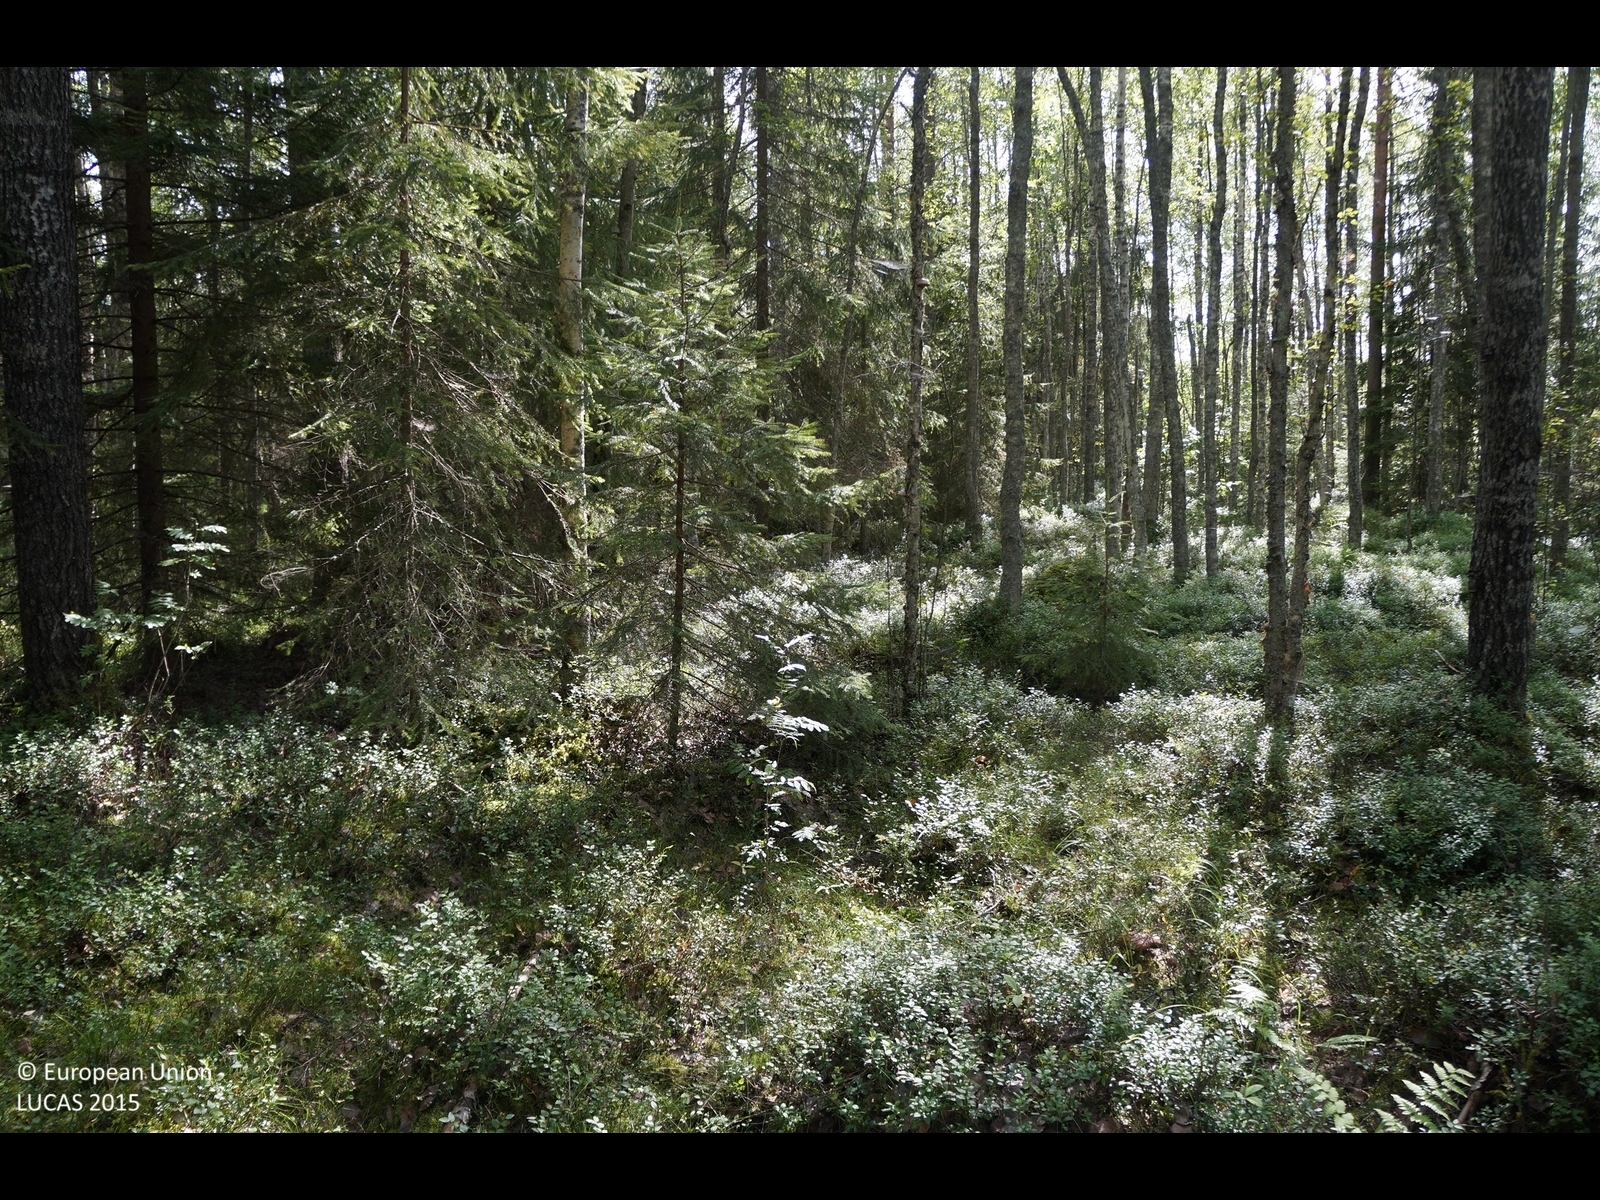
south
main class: Woodland
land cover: Spruce dominated mixed woodland
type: boreal forest
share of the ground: 50 - 75 %
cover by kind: coniferous forest trees 40 %, broadleaved forest trees 30 %, shrubs 25 %, lichens and mosses 5 %
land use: Forestry
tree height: > 5 m
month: August
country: FI
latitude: 64.5885
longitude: 24.7560
